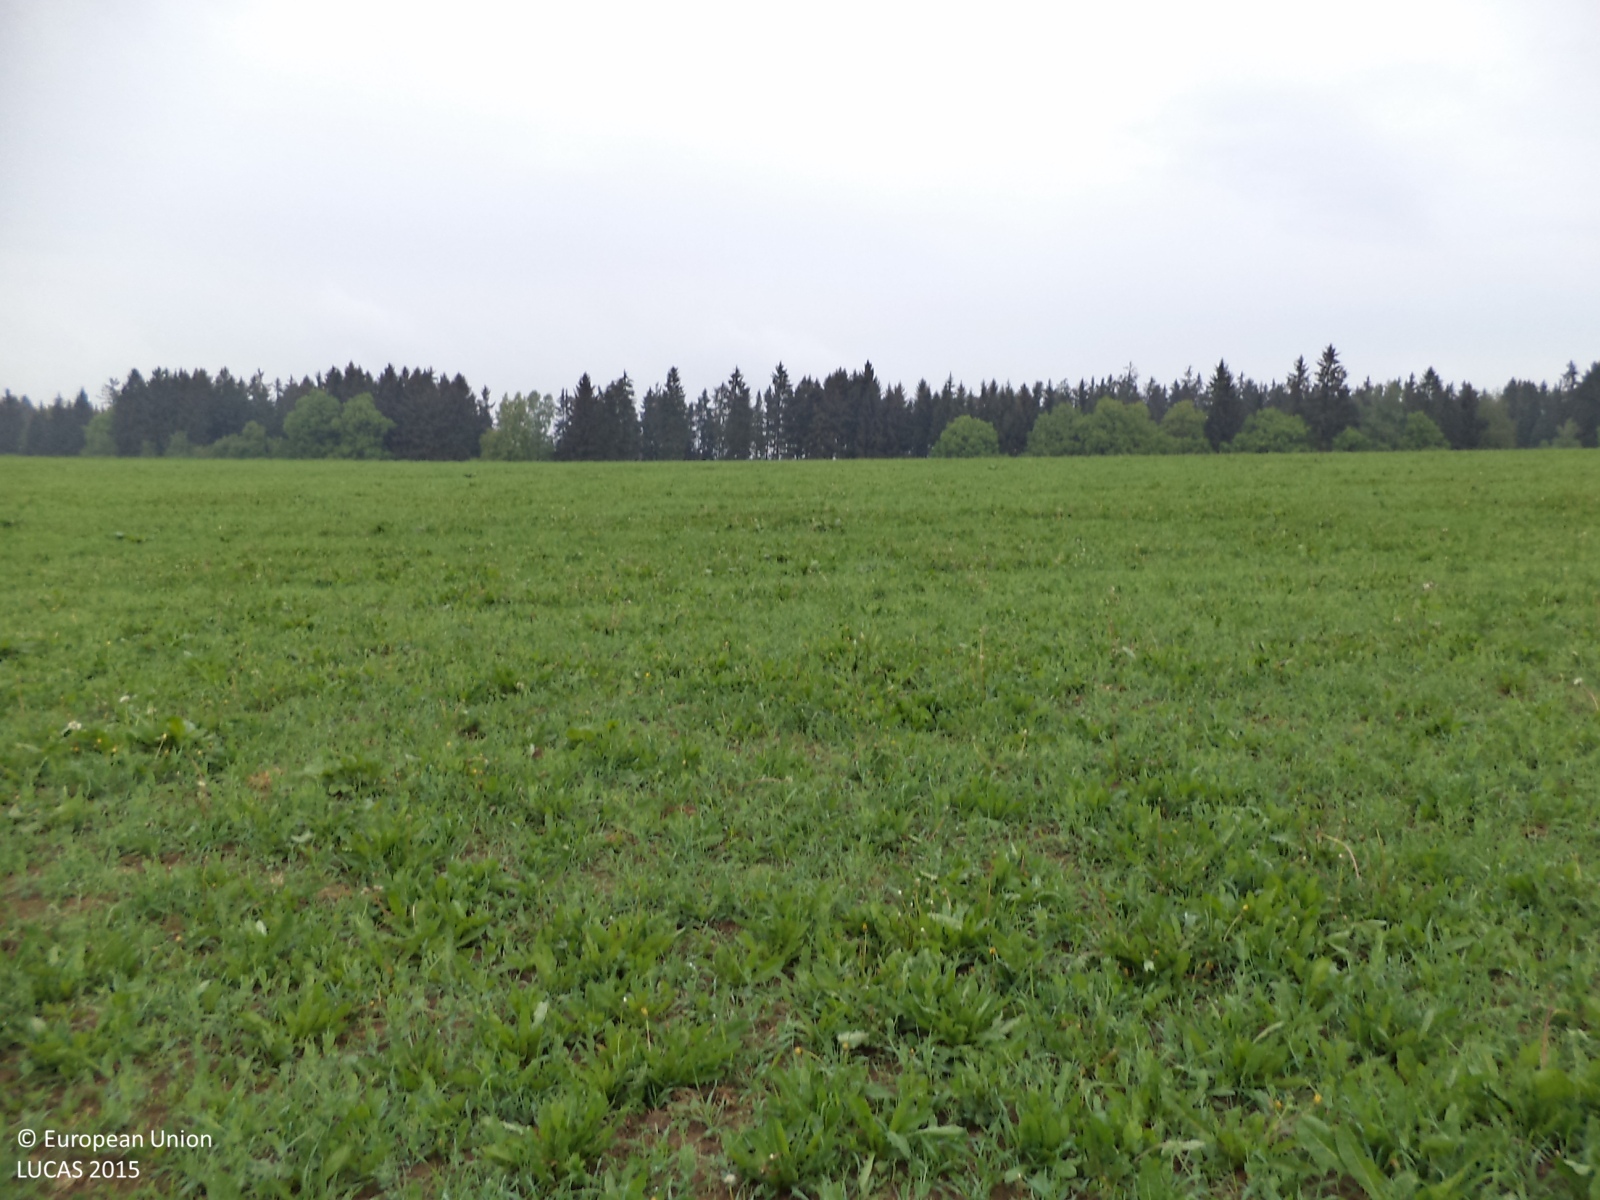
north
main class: Cropland
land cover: Other leguminous and mixtures for fodder
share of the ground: > 75 %
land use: Agriculture (excluding fallow land and kitchen gardens)
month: May
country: CZ
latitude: 49.4113
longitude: 14.9228
